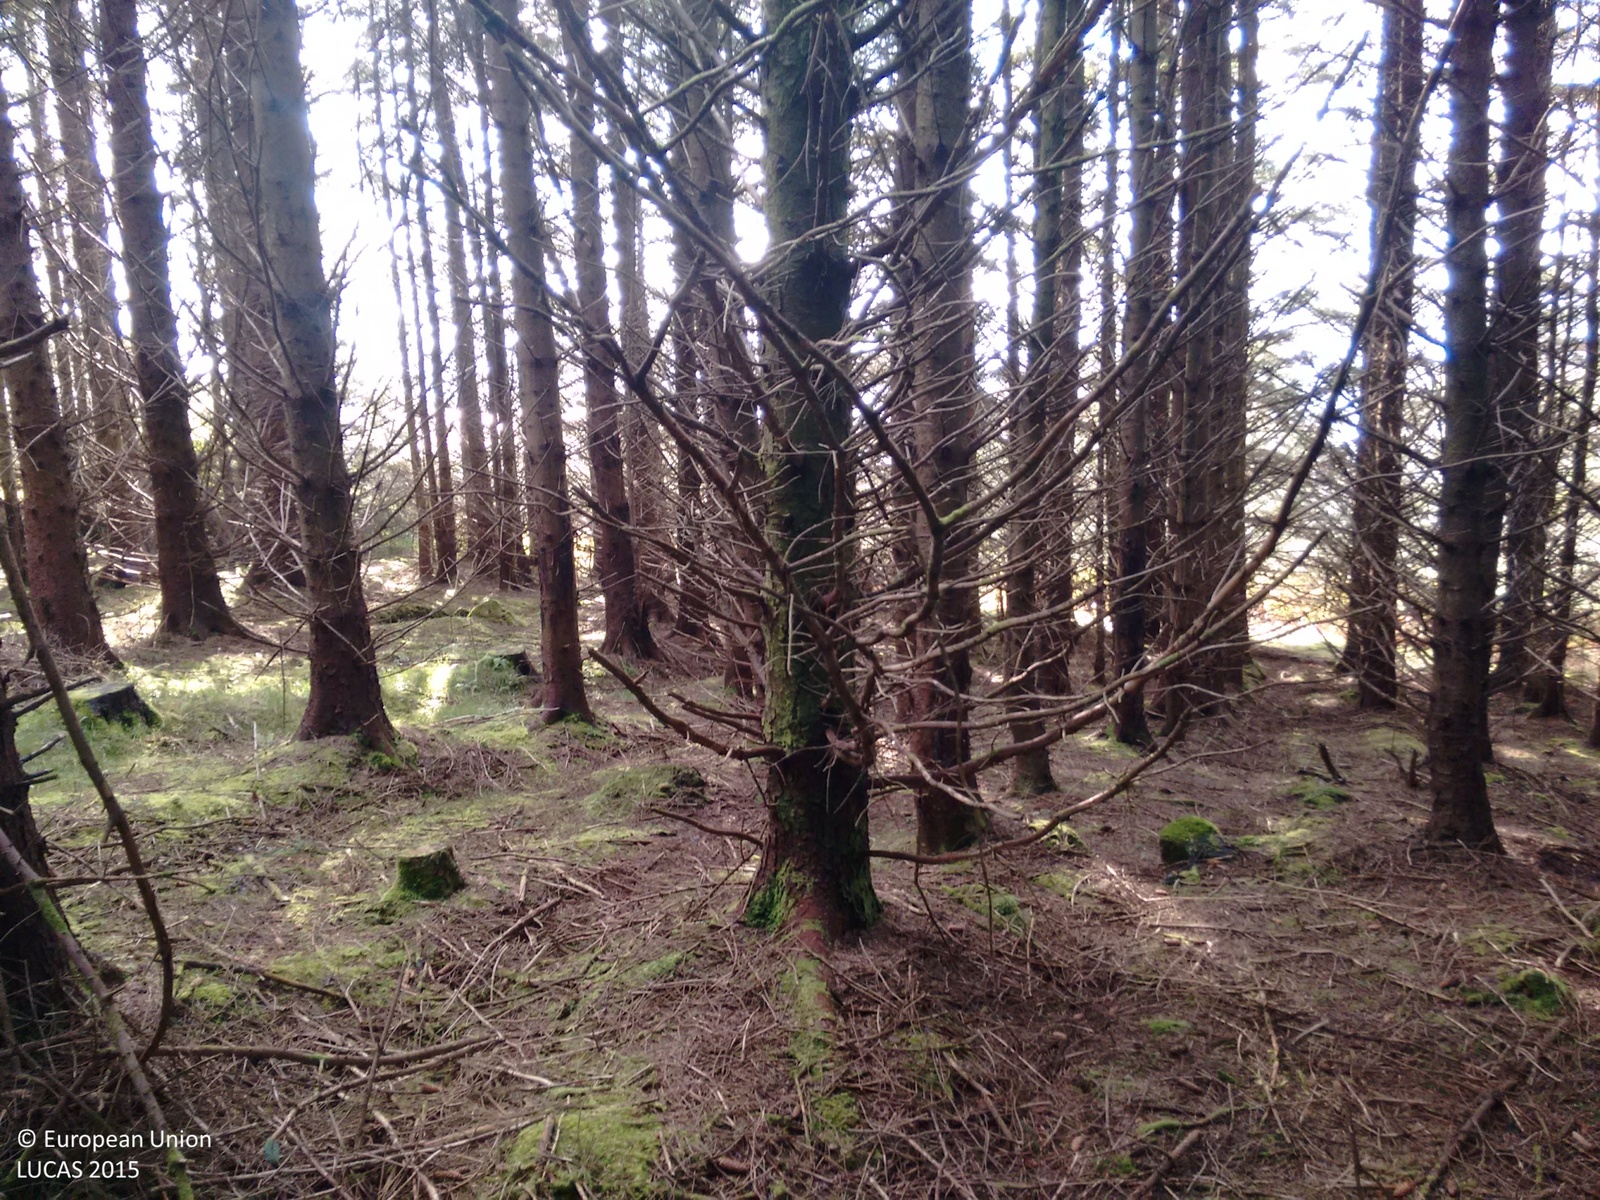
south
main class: Woodland
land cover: Spruce dominated coniferous woodland
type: exotic forest
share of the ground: > 75 %
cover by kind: coniferous forest trees 95 %, herbaceous plants 5 %
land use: Forestry
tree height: > 5 m
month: October
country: GB
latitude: 56.5419
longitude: -5.7891
